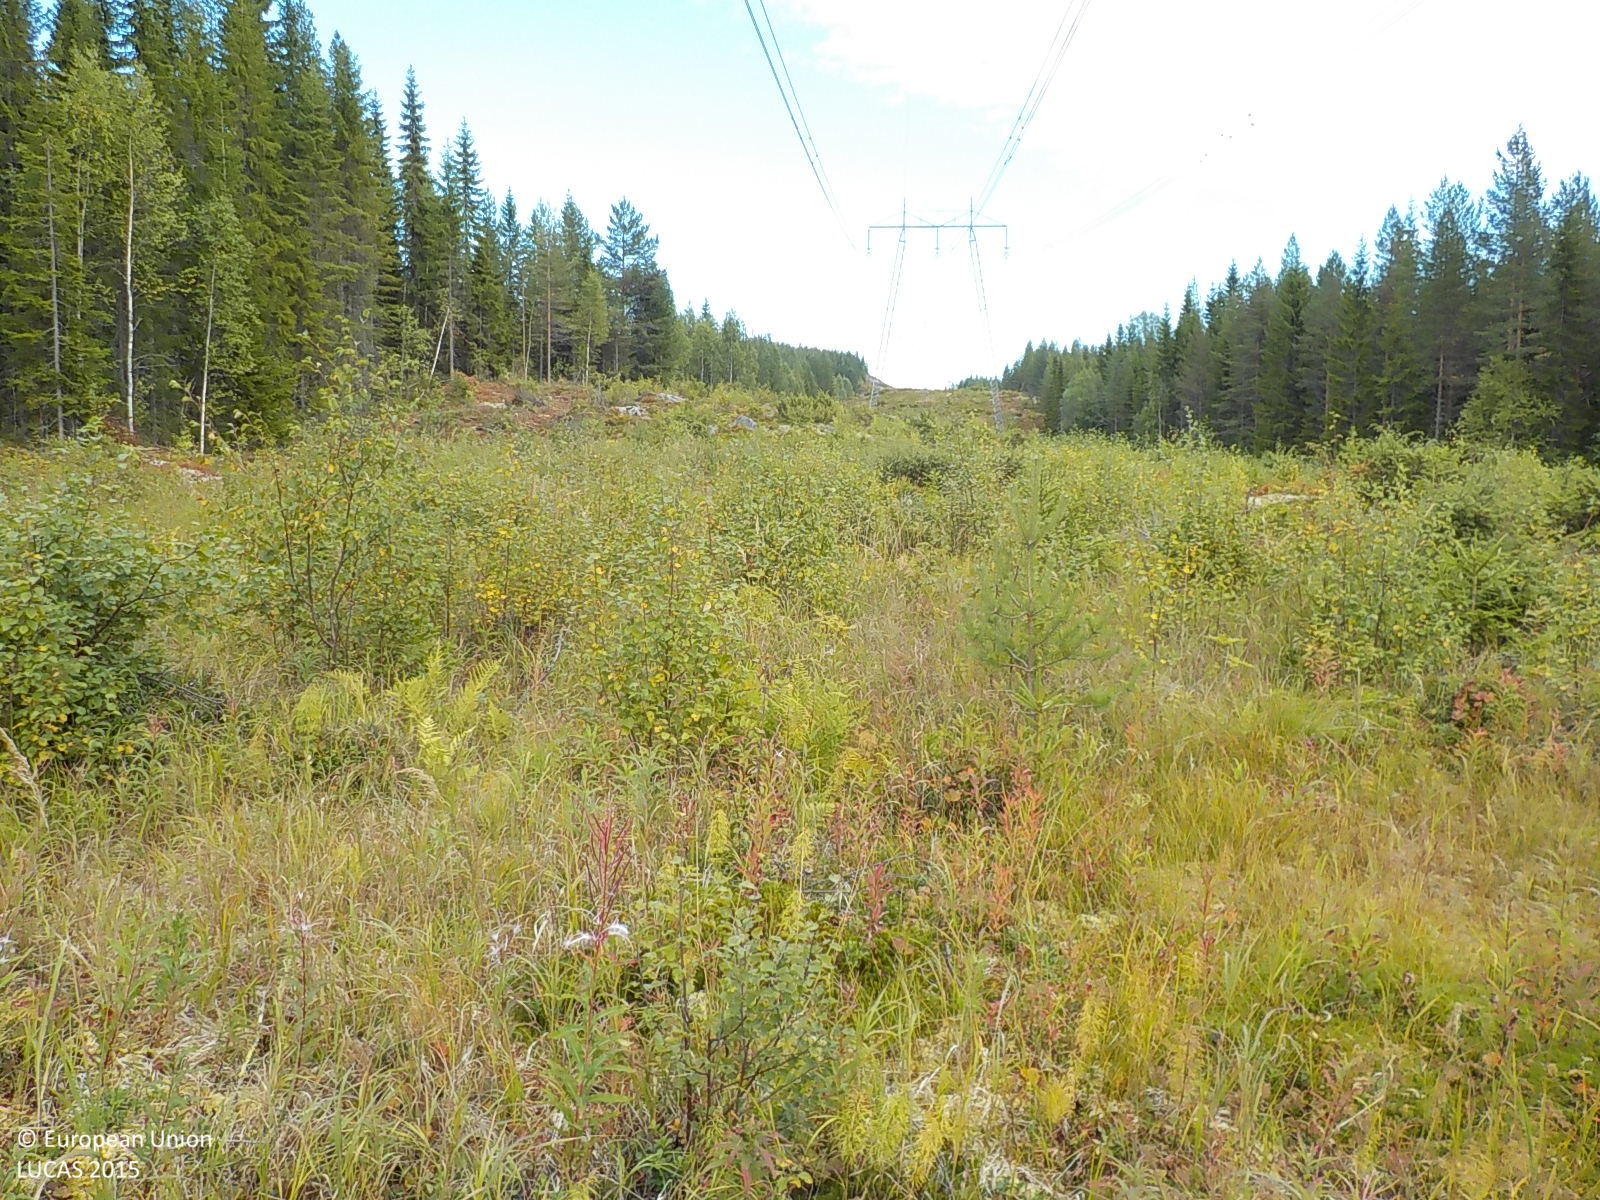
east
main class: Artificial land
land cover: Other artificial areas
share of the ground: 50 - 75 %
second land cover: Broadleaved woodland
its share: 25 - 50 %
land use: Electricity, gas and thermal power distribution
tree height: < 5 m
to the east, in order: Electric lines; Broadleaved woodland; Paved roads, cycling and walking lanes; Broadleaved woodland; Spruce dominated mixed woodland; Pine dominated mixed woodland
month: September
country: SE
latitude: 63.2841
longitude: 17.7314
